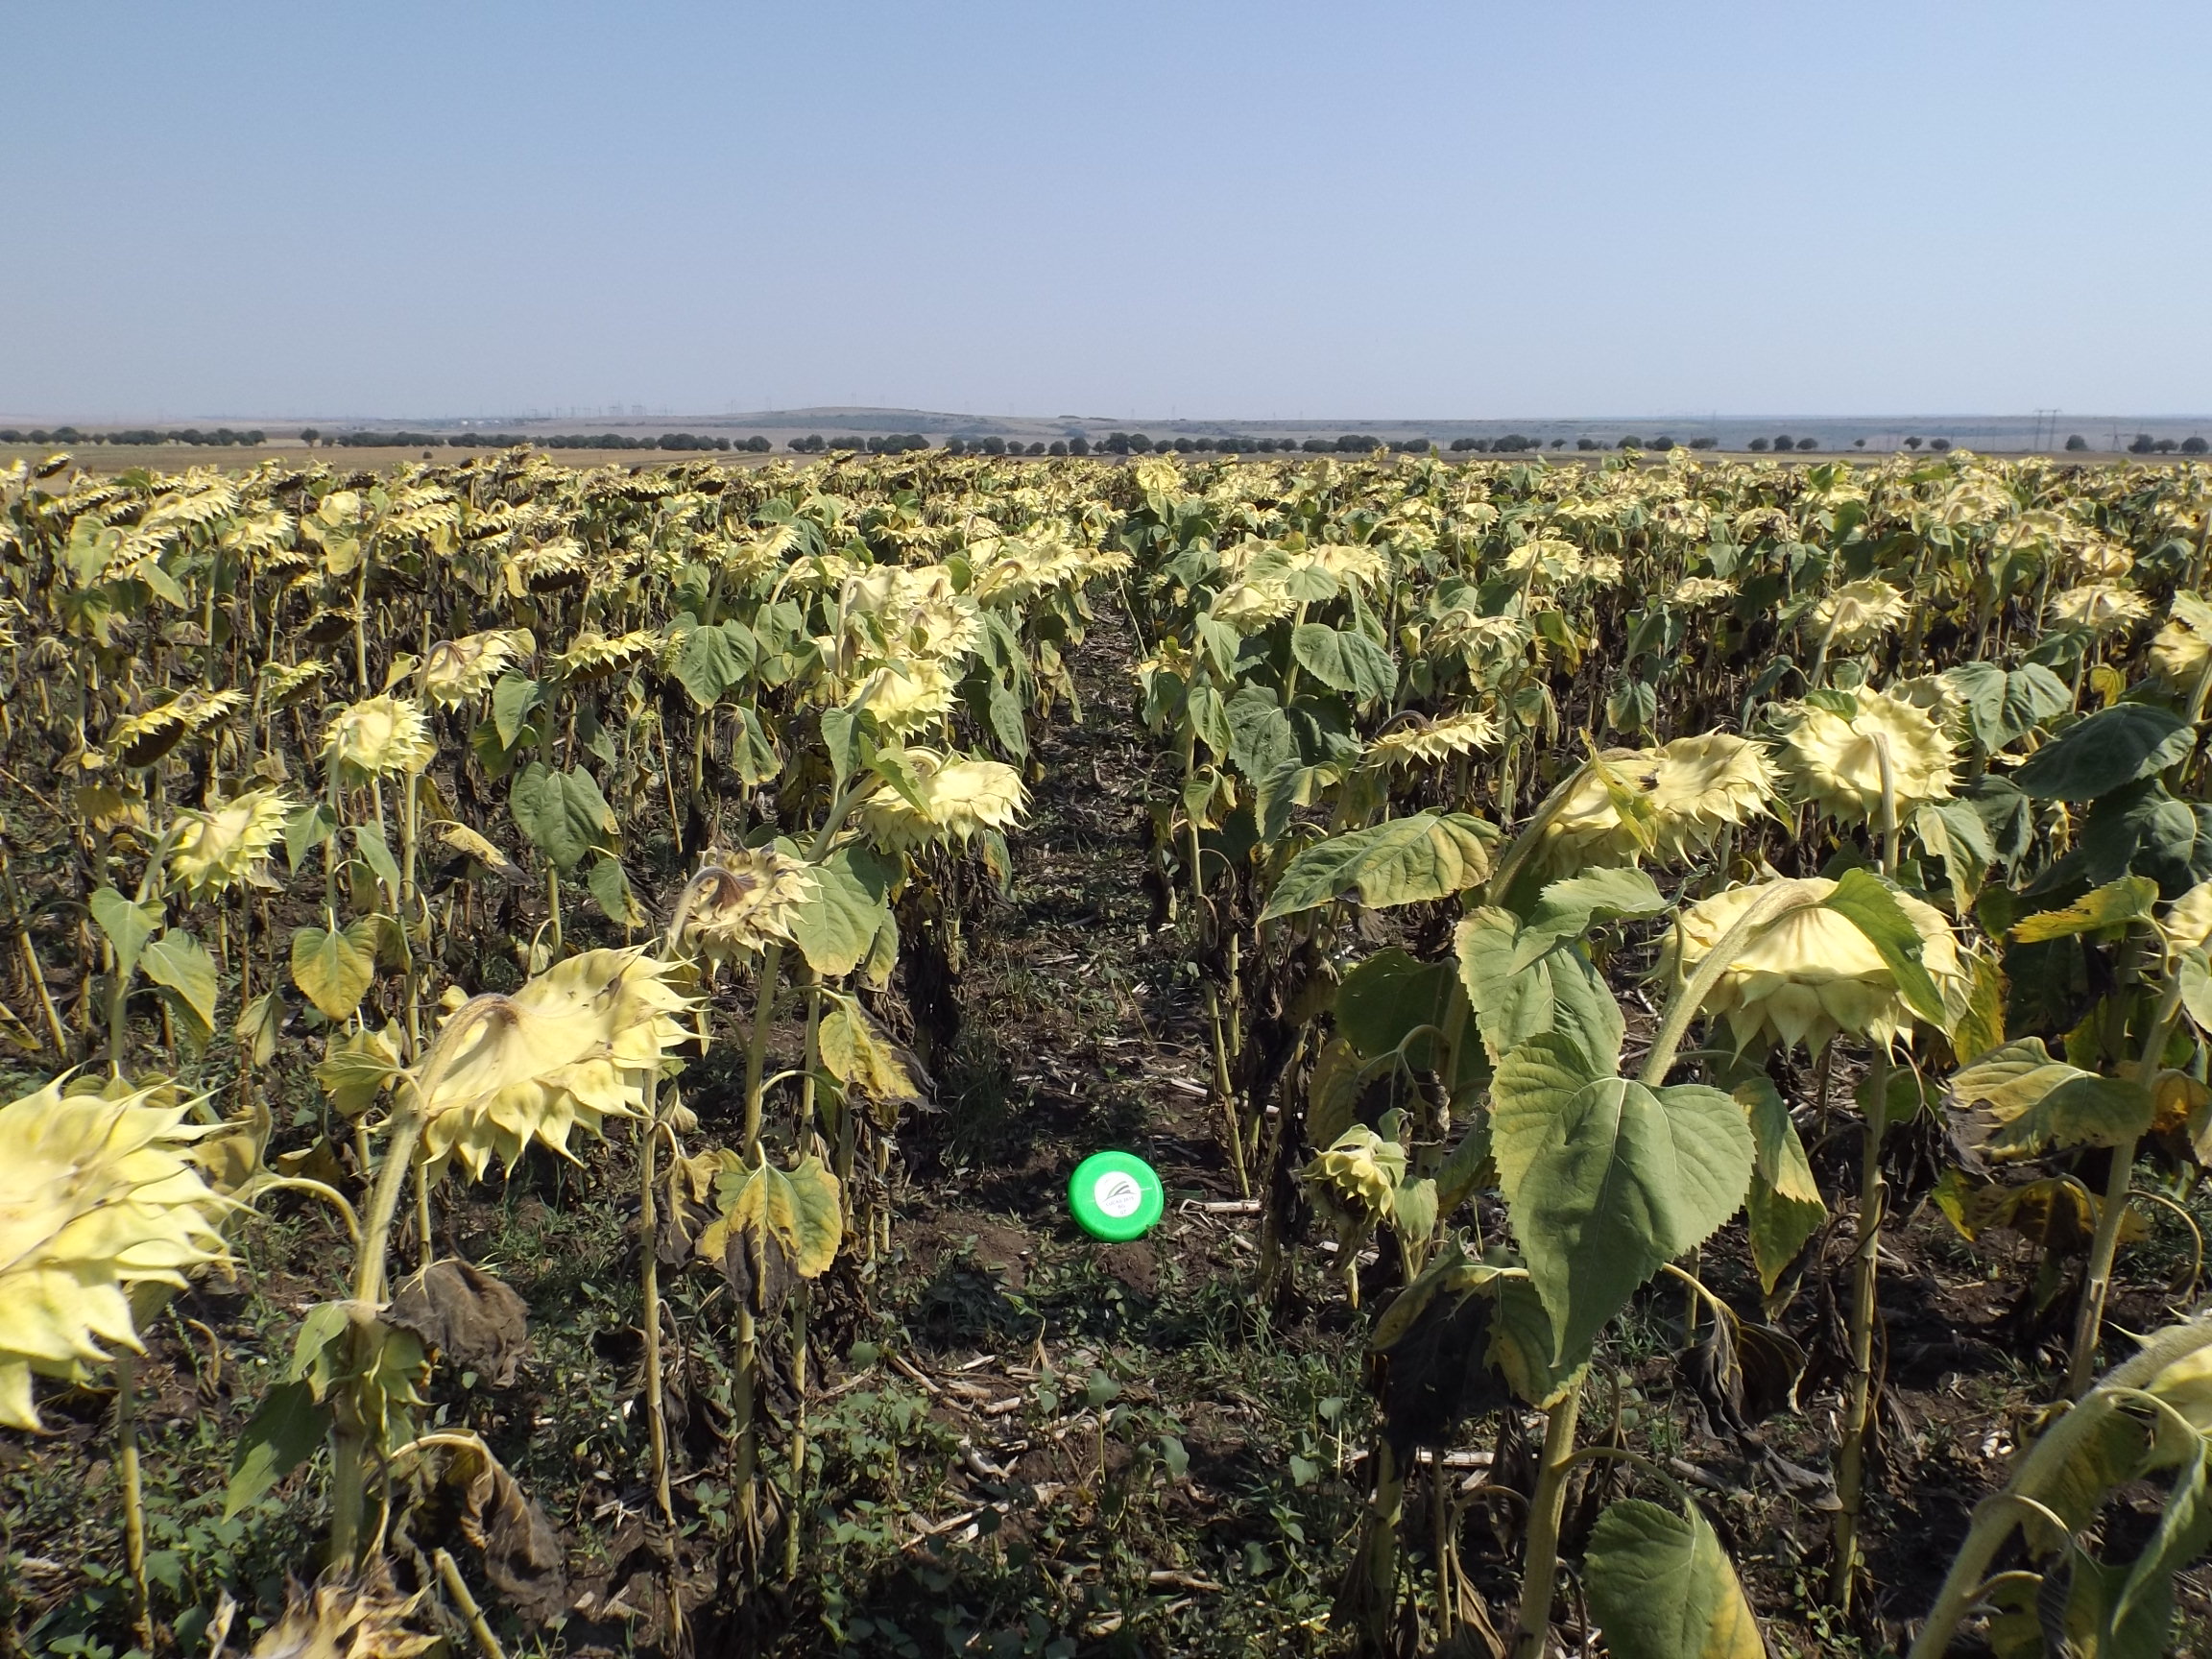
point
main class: Cropland
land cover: Sunflower
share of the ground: 50 - 75 %
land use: Agriculture (excluding fallow land and kitchen gardens)
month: August
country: BG
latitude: 43.2748
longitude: 27.4893
